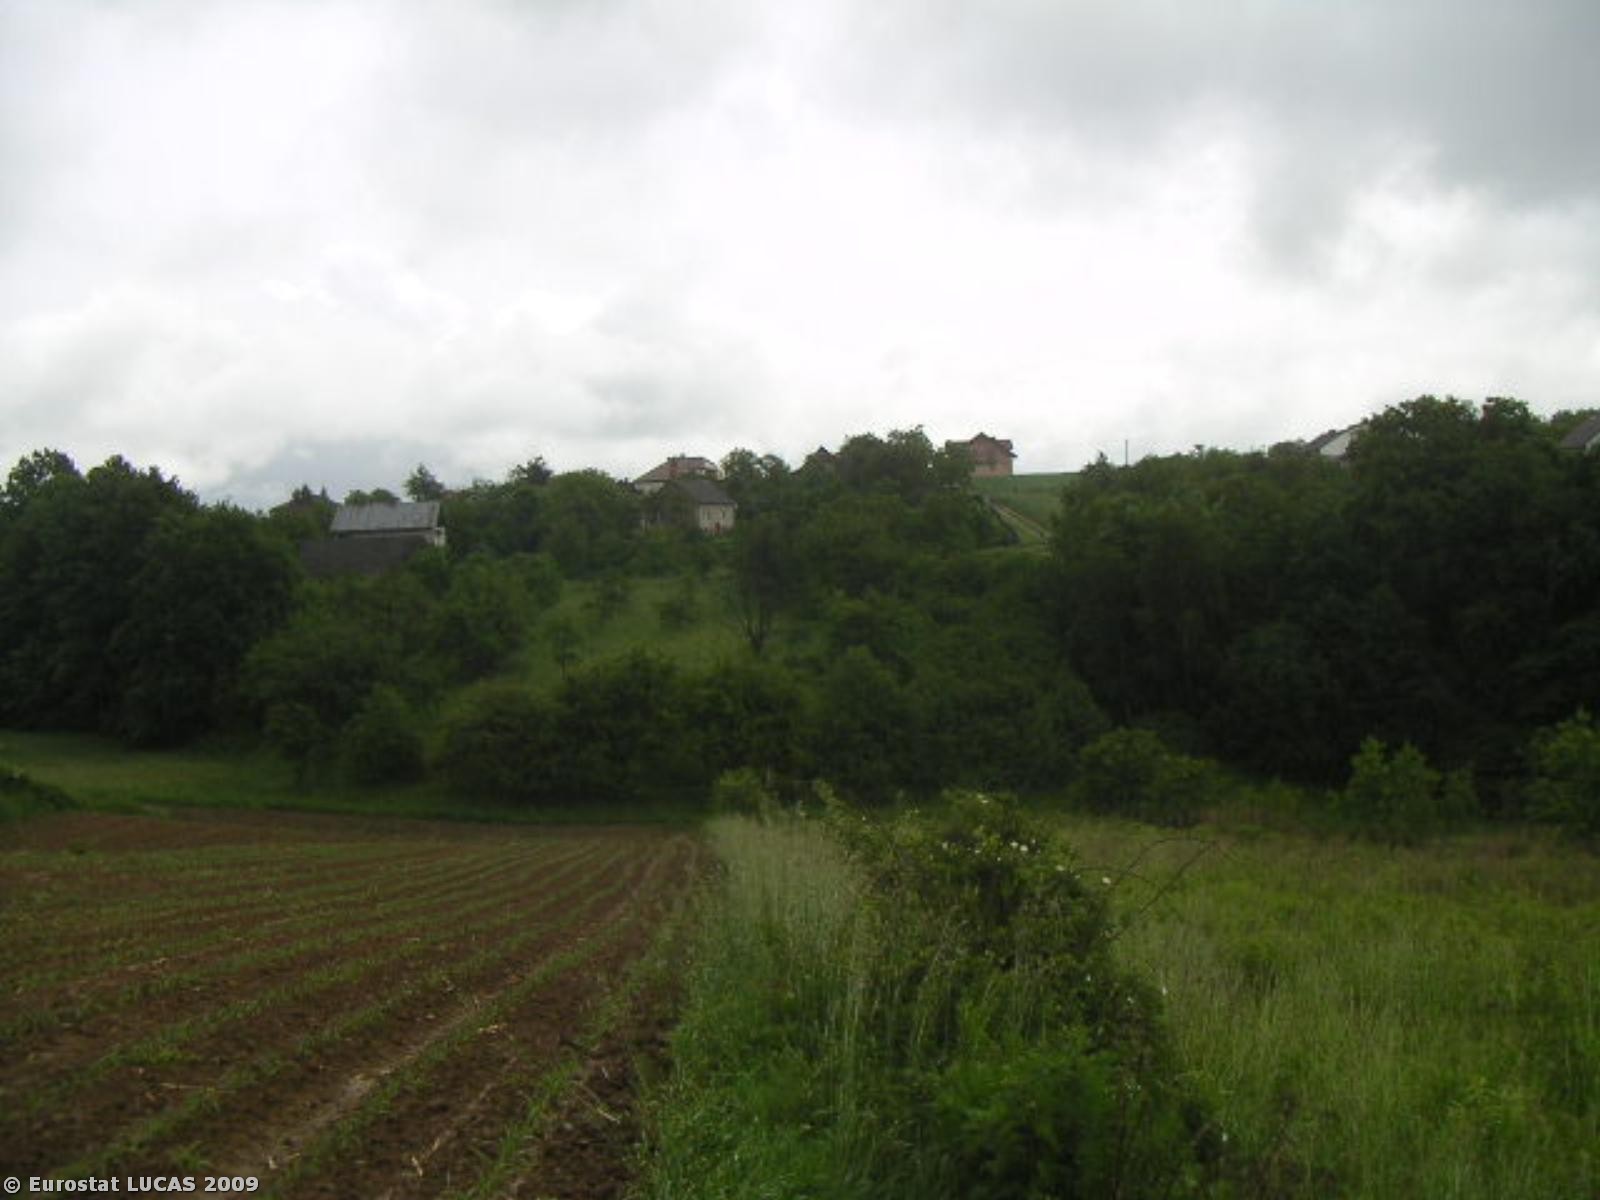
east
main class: Cropland
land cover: Maize
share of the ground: 50 - 75 %
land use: Agriculture (excluding fallow land and kitchen gardens)
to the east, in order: Maize; Tracks; Groves; Grass margins; Tracks; Grassland without tree/shrub cover
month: May
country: PL
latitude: 50.0635
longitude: 19.6538
